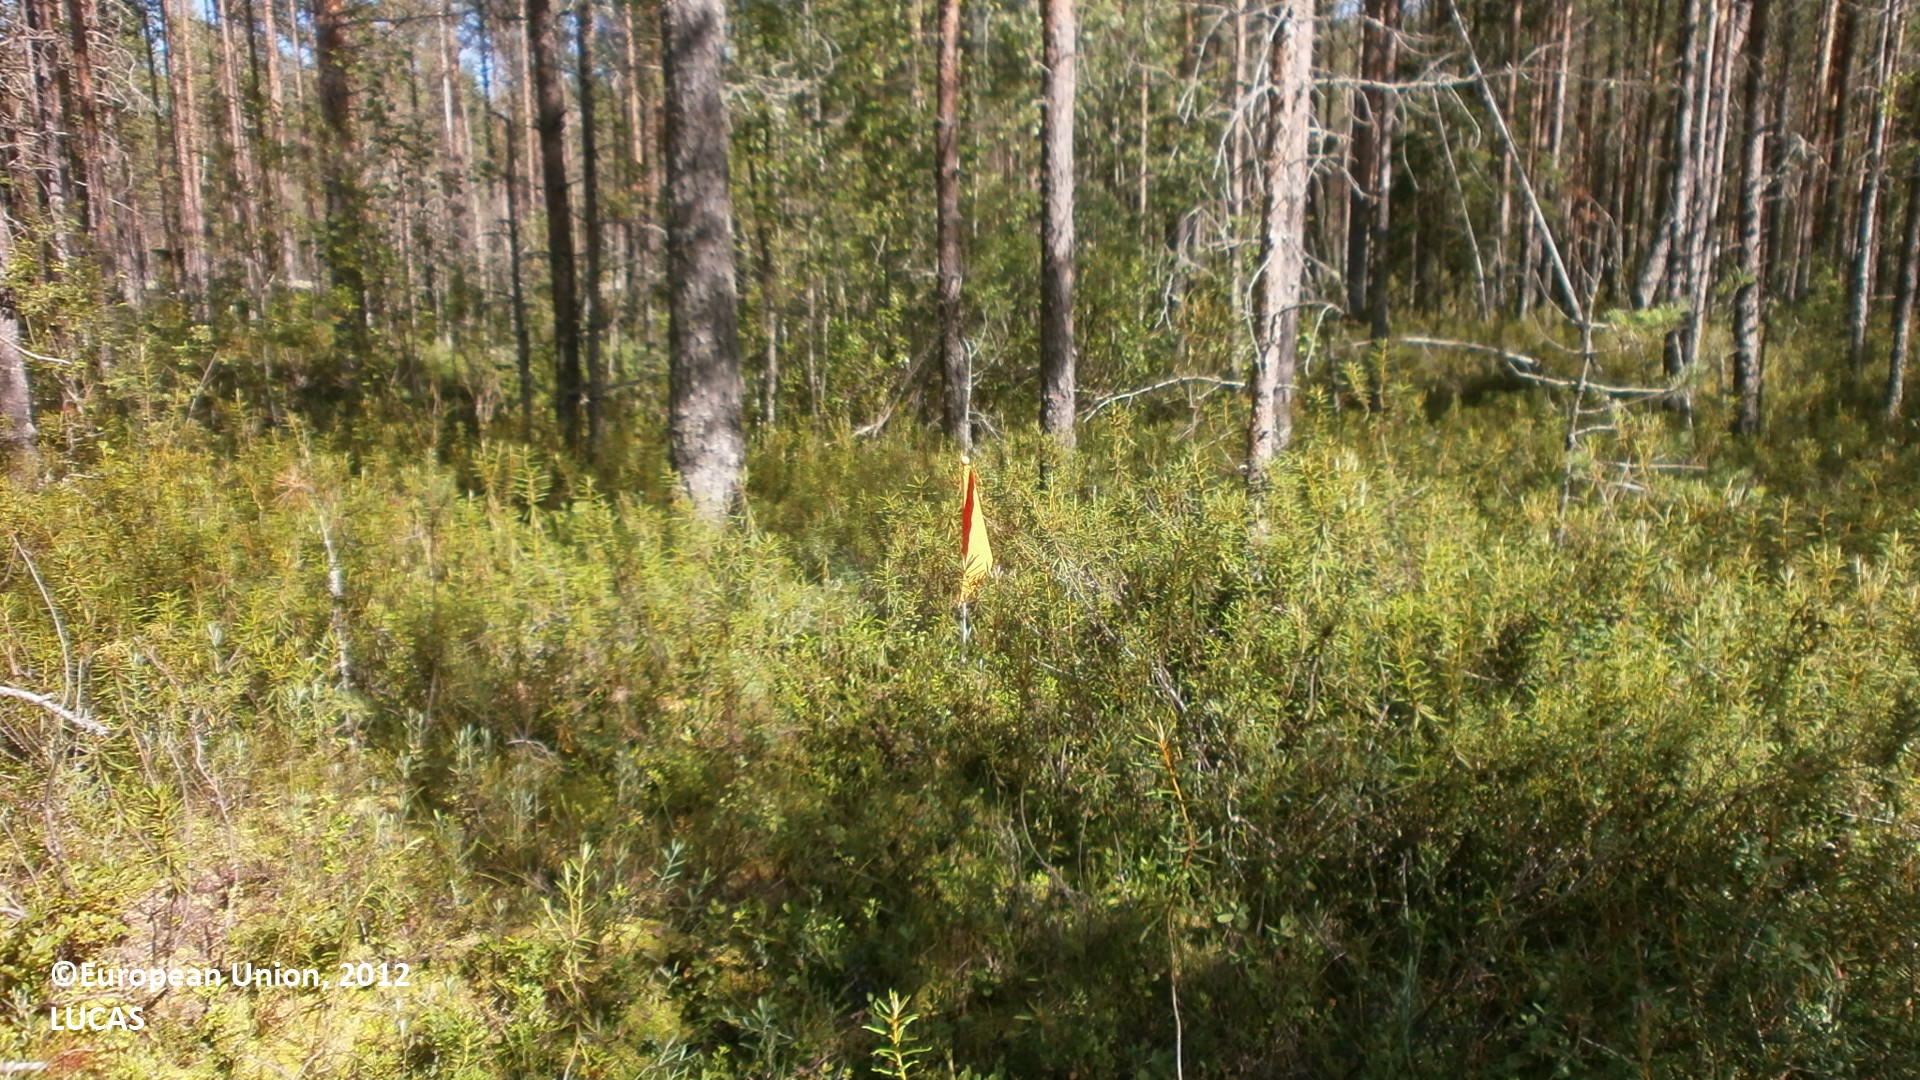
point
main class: Woodland
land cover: Pine dominated coniferous woodland
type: mire and swamp forests
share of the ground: 50 - 75 %
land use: Forestry
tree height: > 5 m
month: July
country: FI
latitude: 64.1462
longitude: 24.3548
